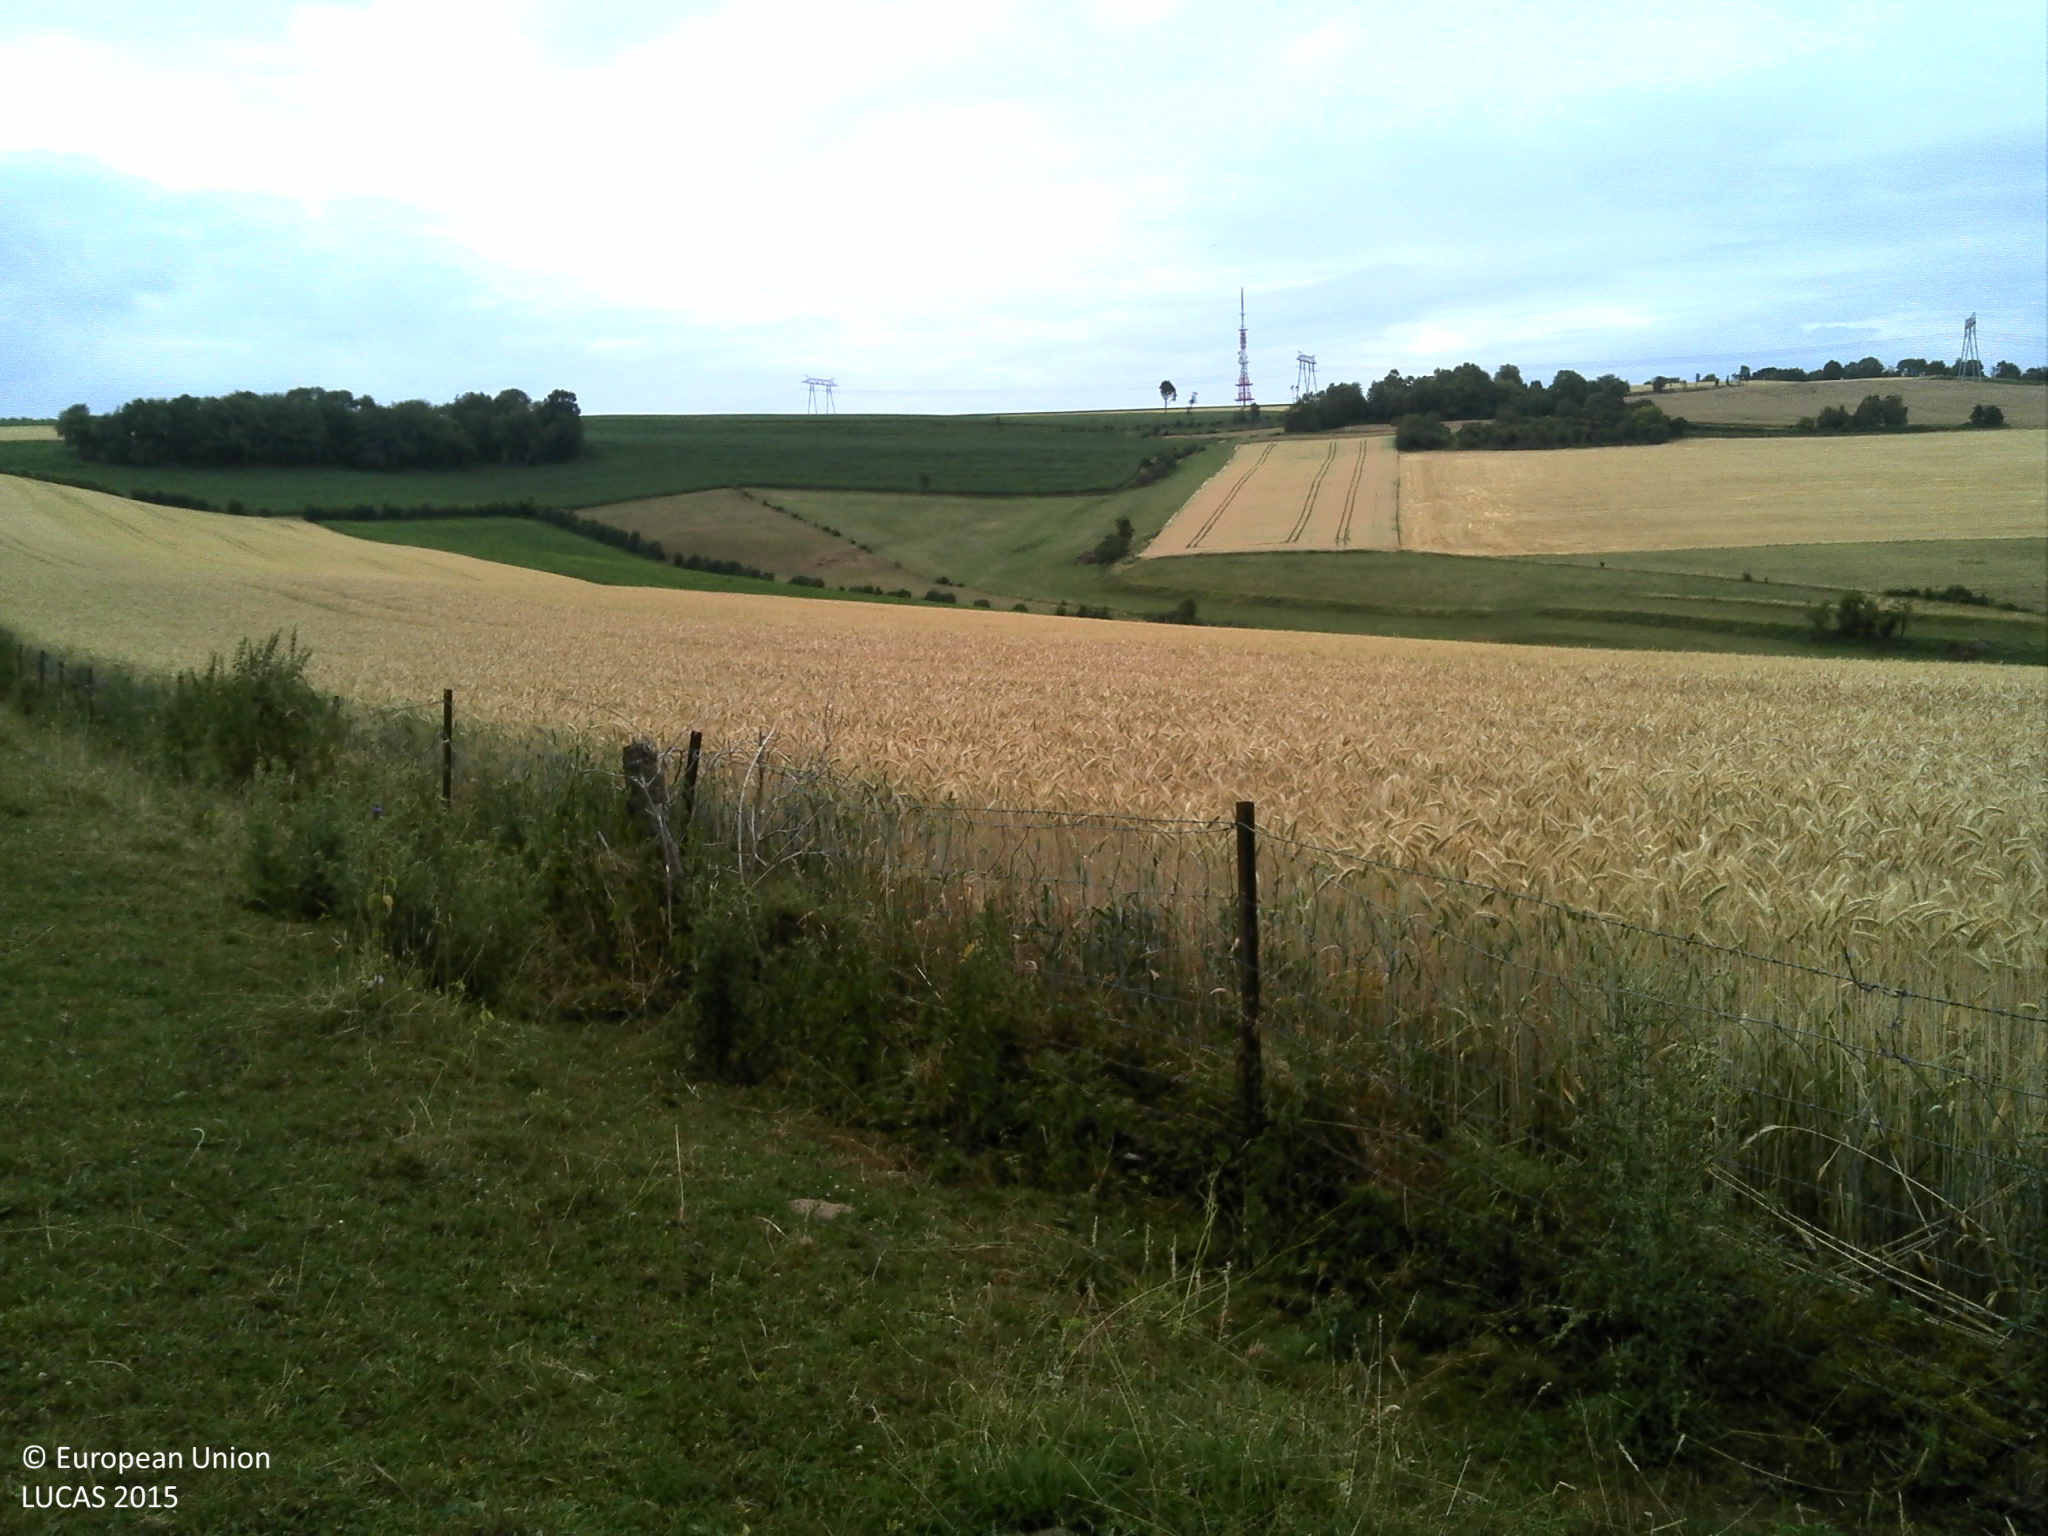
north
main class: Grassland
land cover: Grassland without tree/shrub cover
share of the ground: > 75 %
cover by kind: herbaceous plants 100 %
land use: Agriculture (excluding fallow land and kitchen gardens)
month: July
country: FR
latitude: 49.7498
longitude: 4.5975
